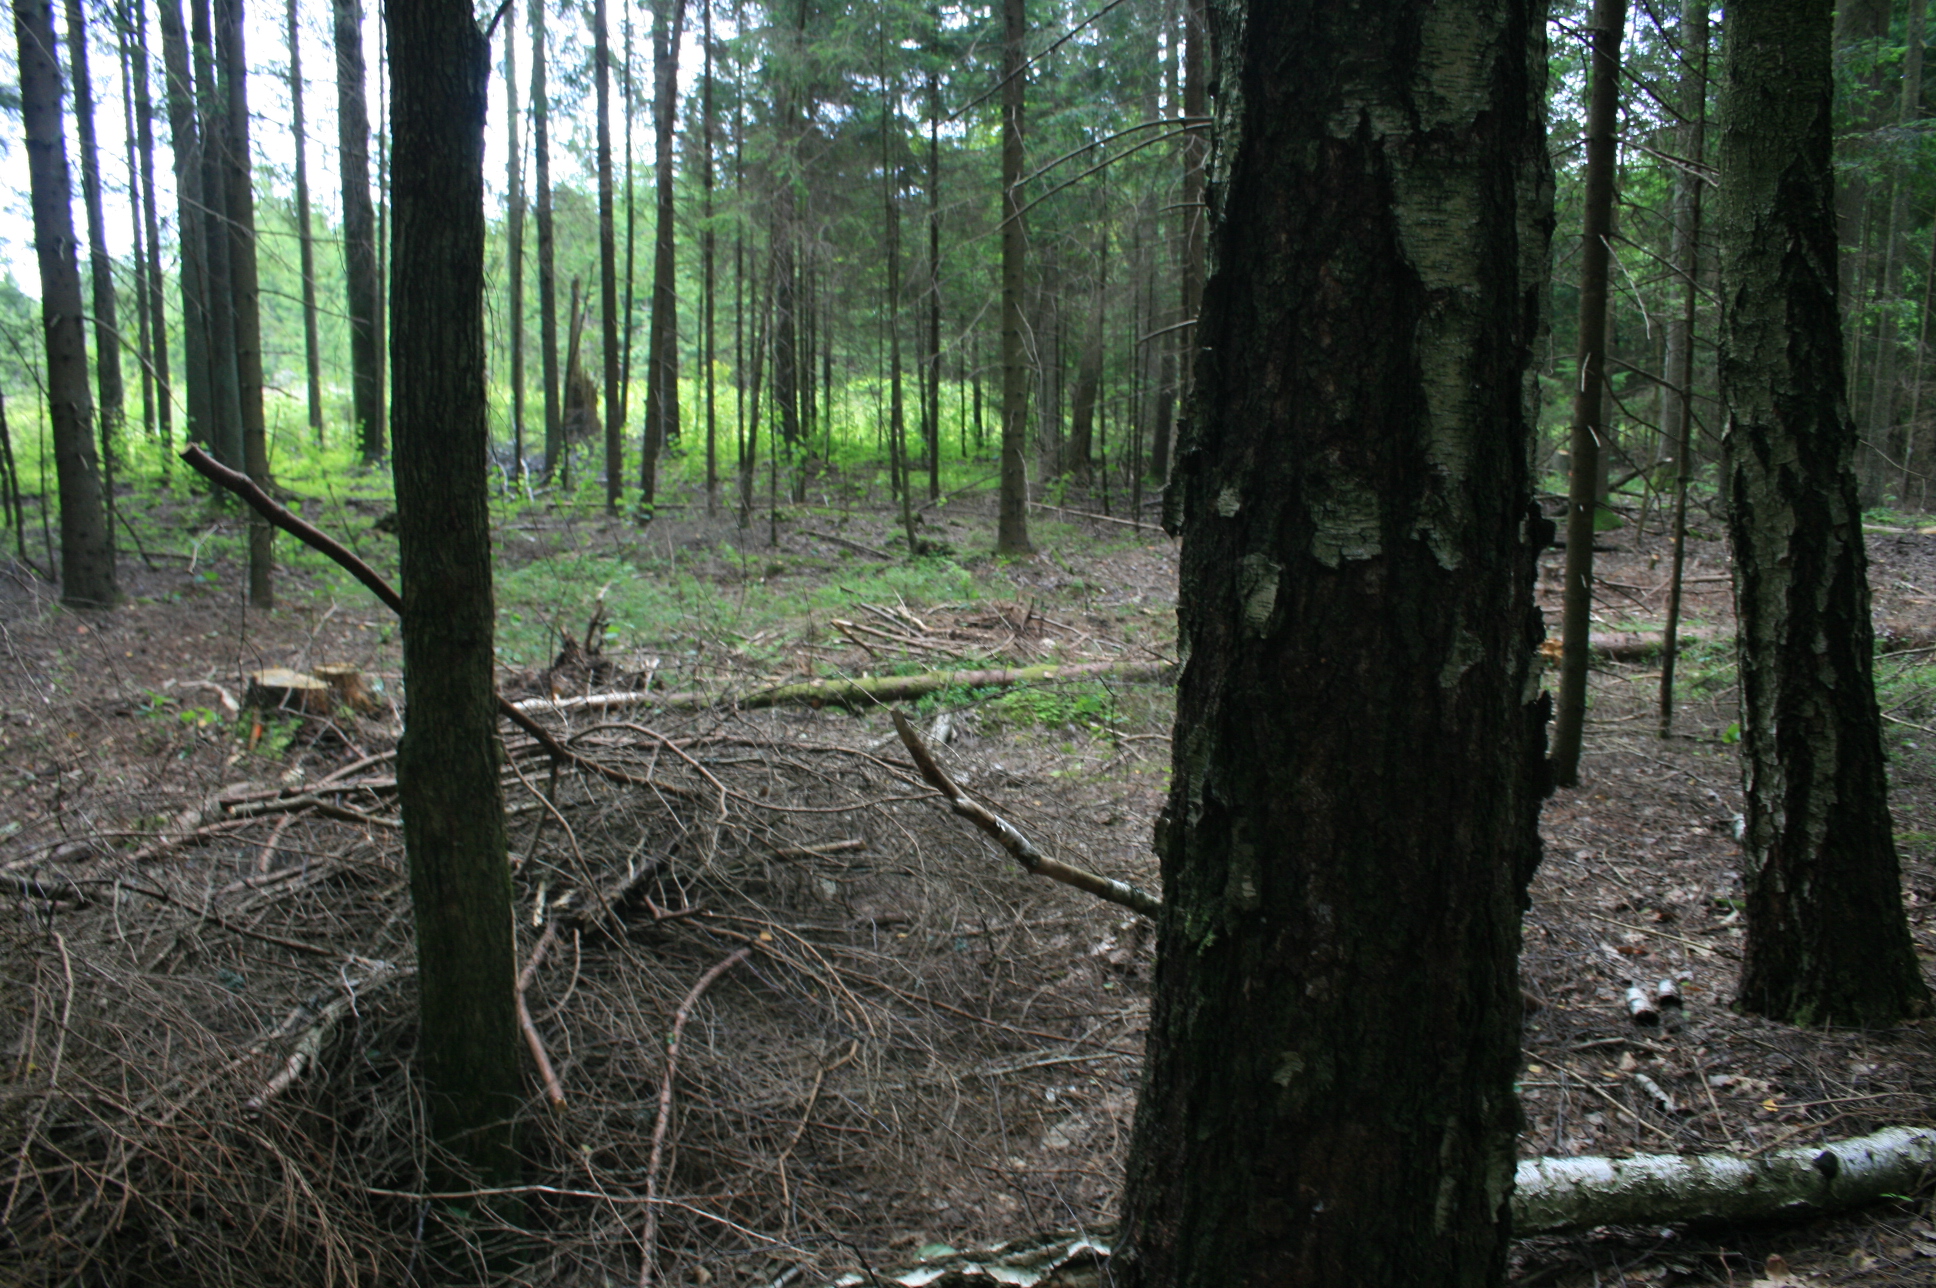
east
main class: Woodland
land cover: Spruce dominated mixed woodland
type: hemiboreal forest and nemoral coniferous forest and mixed broadleaved-coniferous forest
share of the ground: > 75 %
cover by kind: coniferous forest trees 65 %, broadleaved forest trees 30 %, herbaceous plants 5 %
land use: Forestry
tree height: > 5 m
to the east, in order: Spruce dominated mixed woodland; Grass margins; Paved roads, cycling and walking lanes; Grass margins; Shrubland without tree cover; Spruce dominated coniferous woodland; Broadleaved woodland; Spontaneously vegetated surfaces; Ditches and canals; Spontaneously vegetated surfaces; Spruce dominated mixed woodland
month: July
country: LT
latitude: 55.4798
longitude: 21.7743
